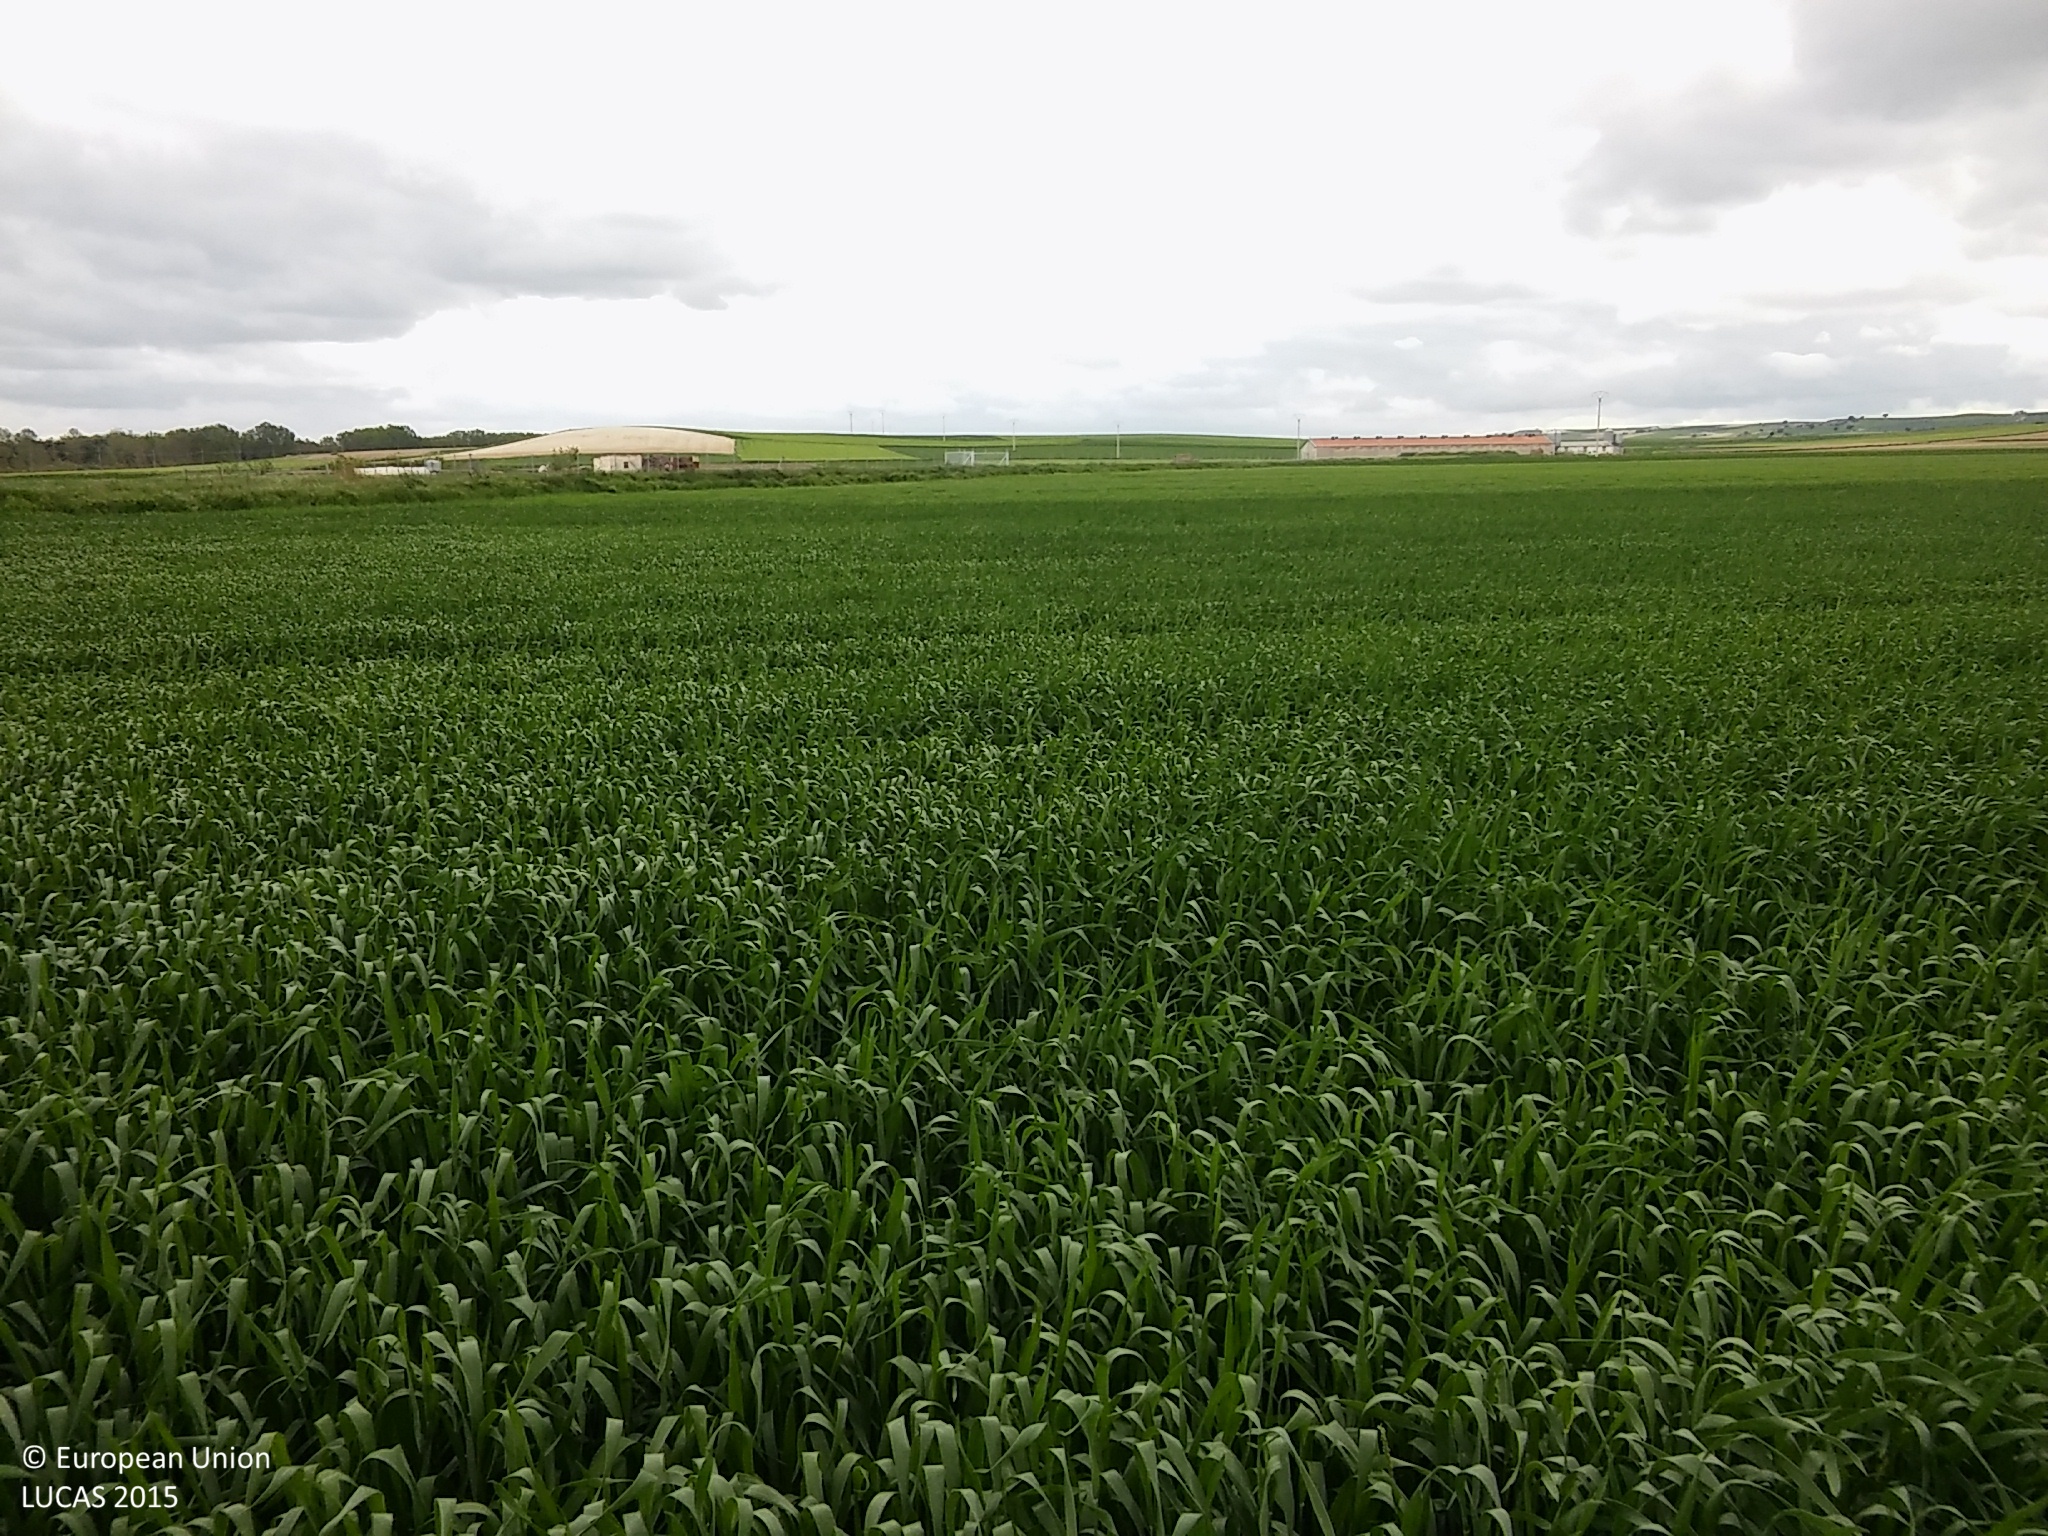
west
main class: Cropland
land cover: Barley
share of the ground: > 75 %
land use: Agriculture (excluding fallow land and kitchen gardens)
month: May
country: ES
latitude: 41.3888
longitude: -3.9618
